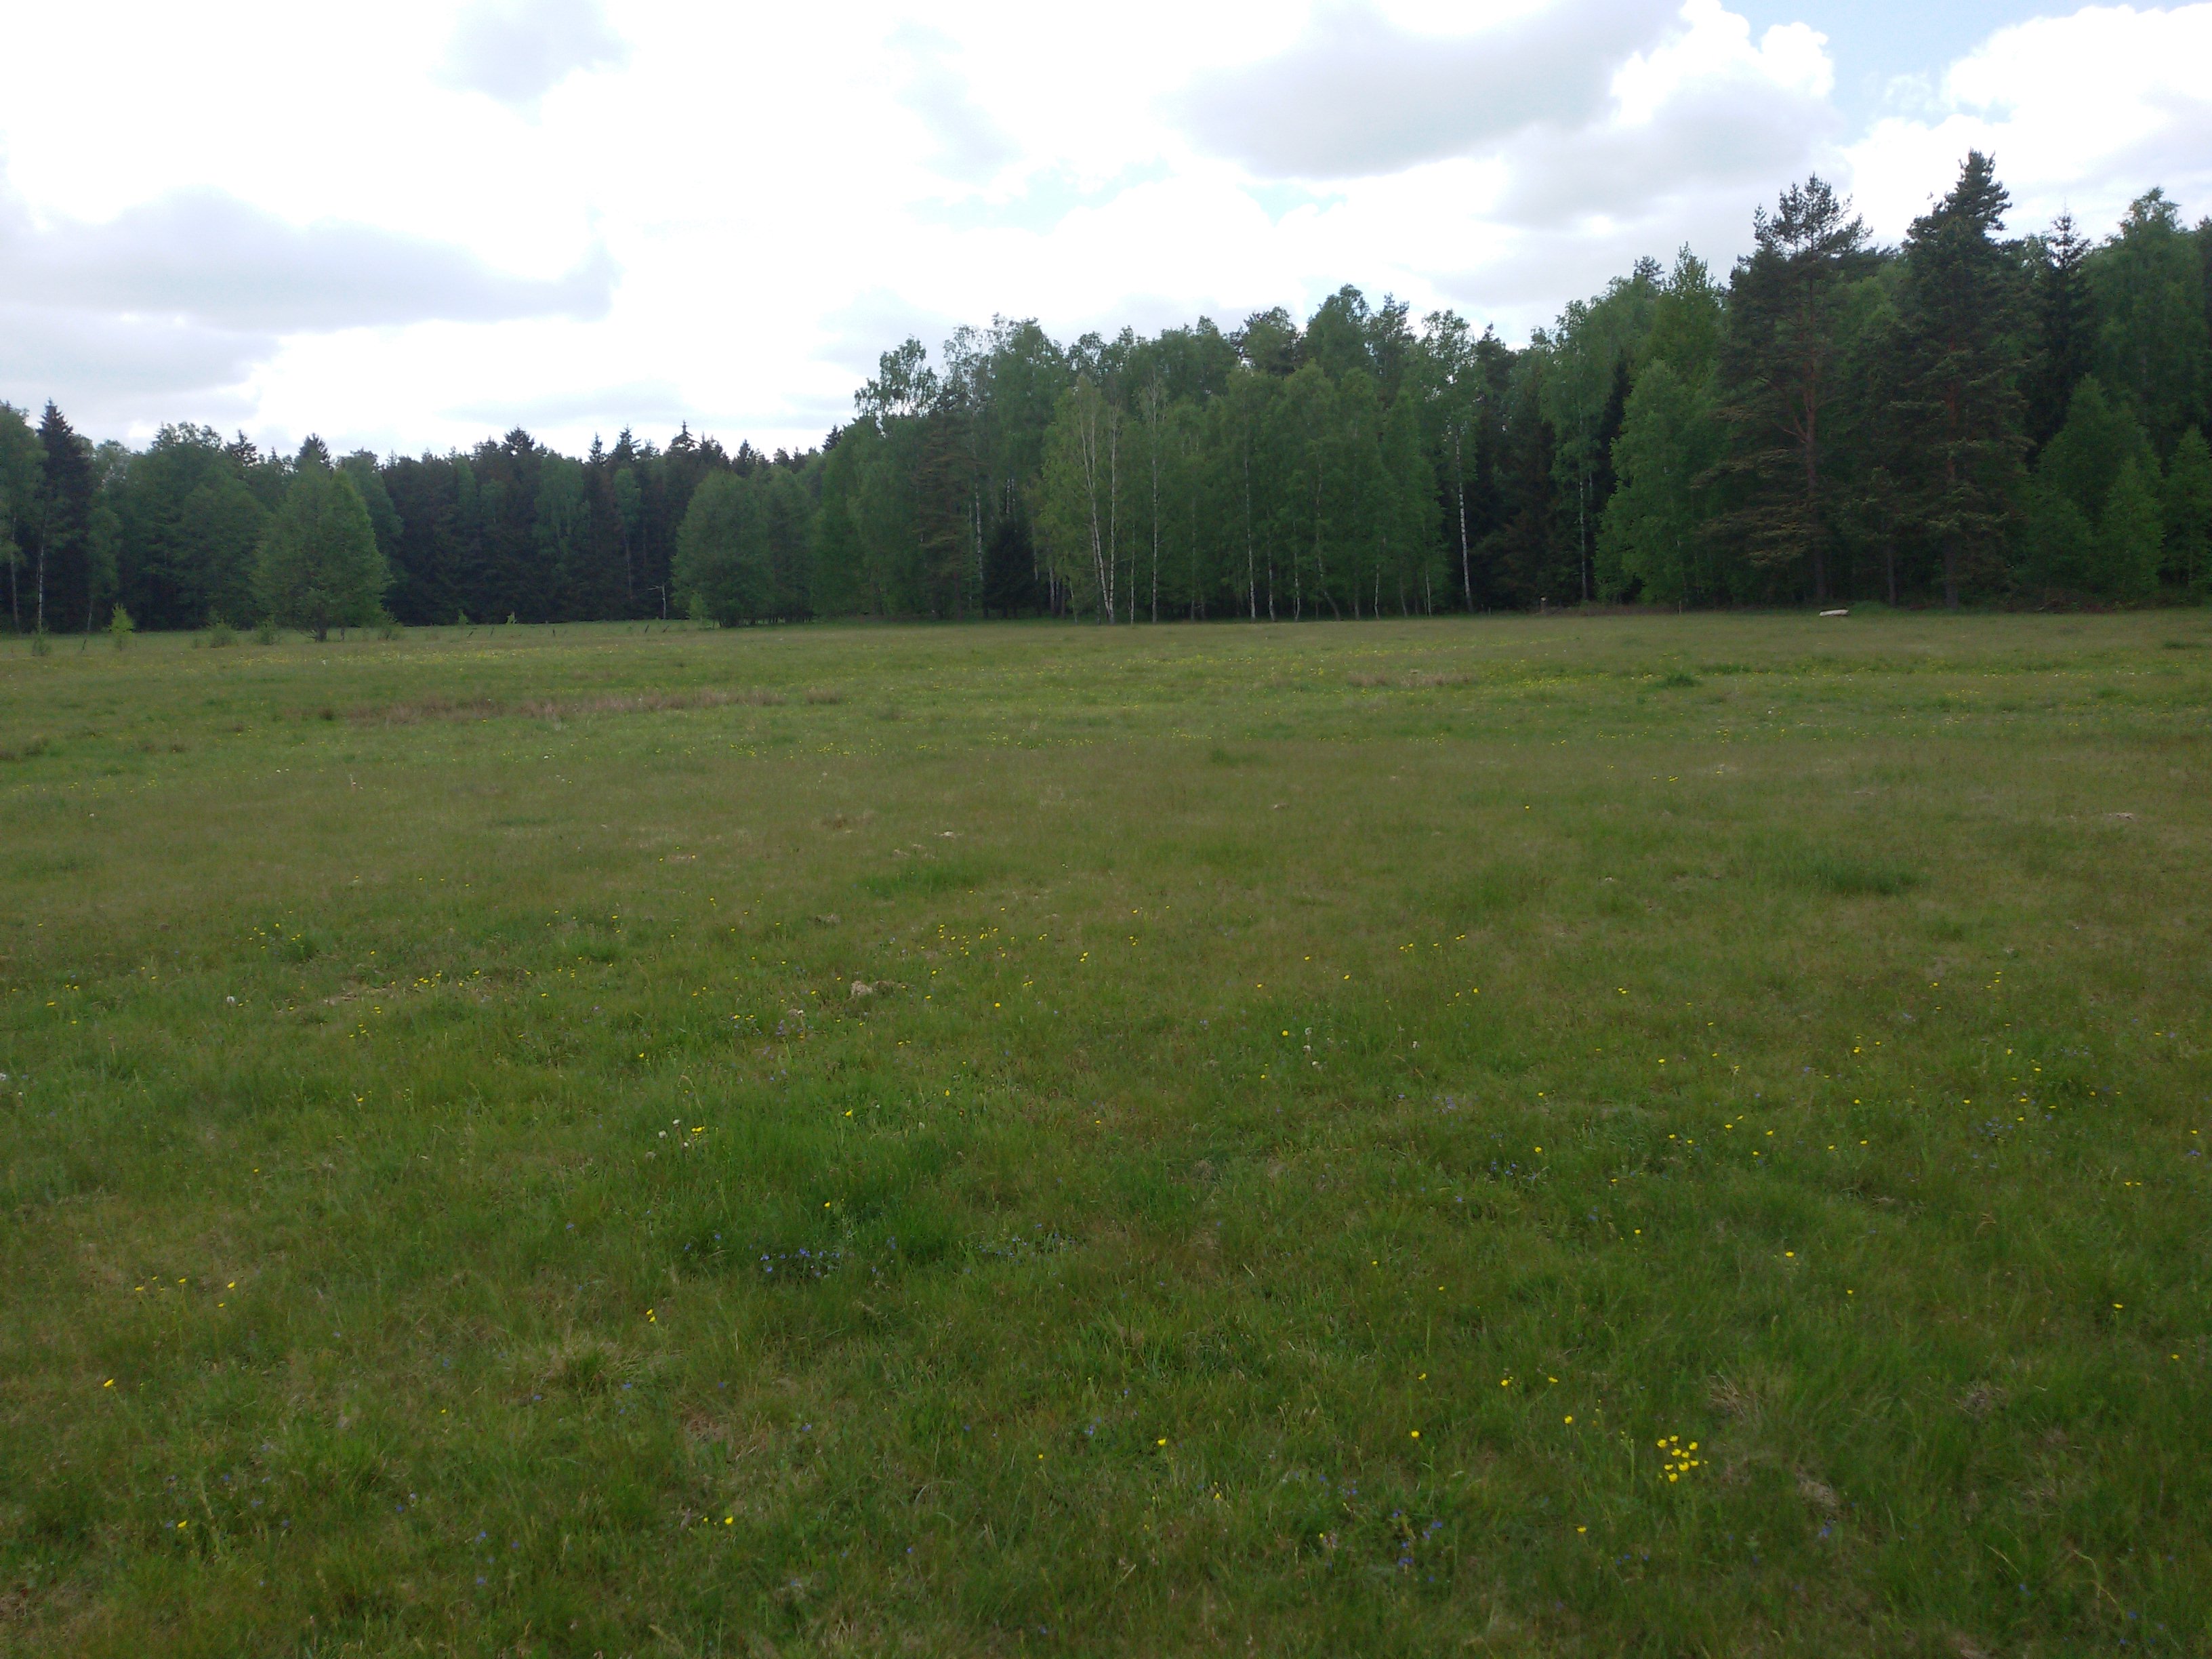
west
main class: Grassland
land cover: Grassland without tree/shrub cover
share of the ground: > 75 %
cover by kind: herbaceous plants 100 %
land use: Agriculture (excluding fallow land and kitchen gardens)
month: May
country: PL
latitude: 53.5129
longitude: 21.0372
